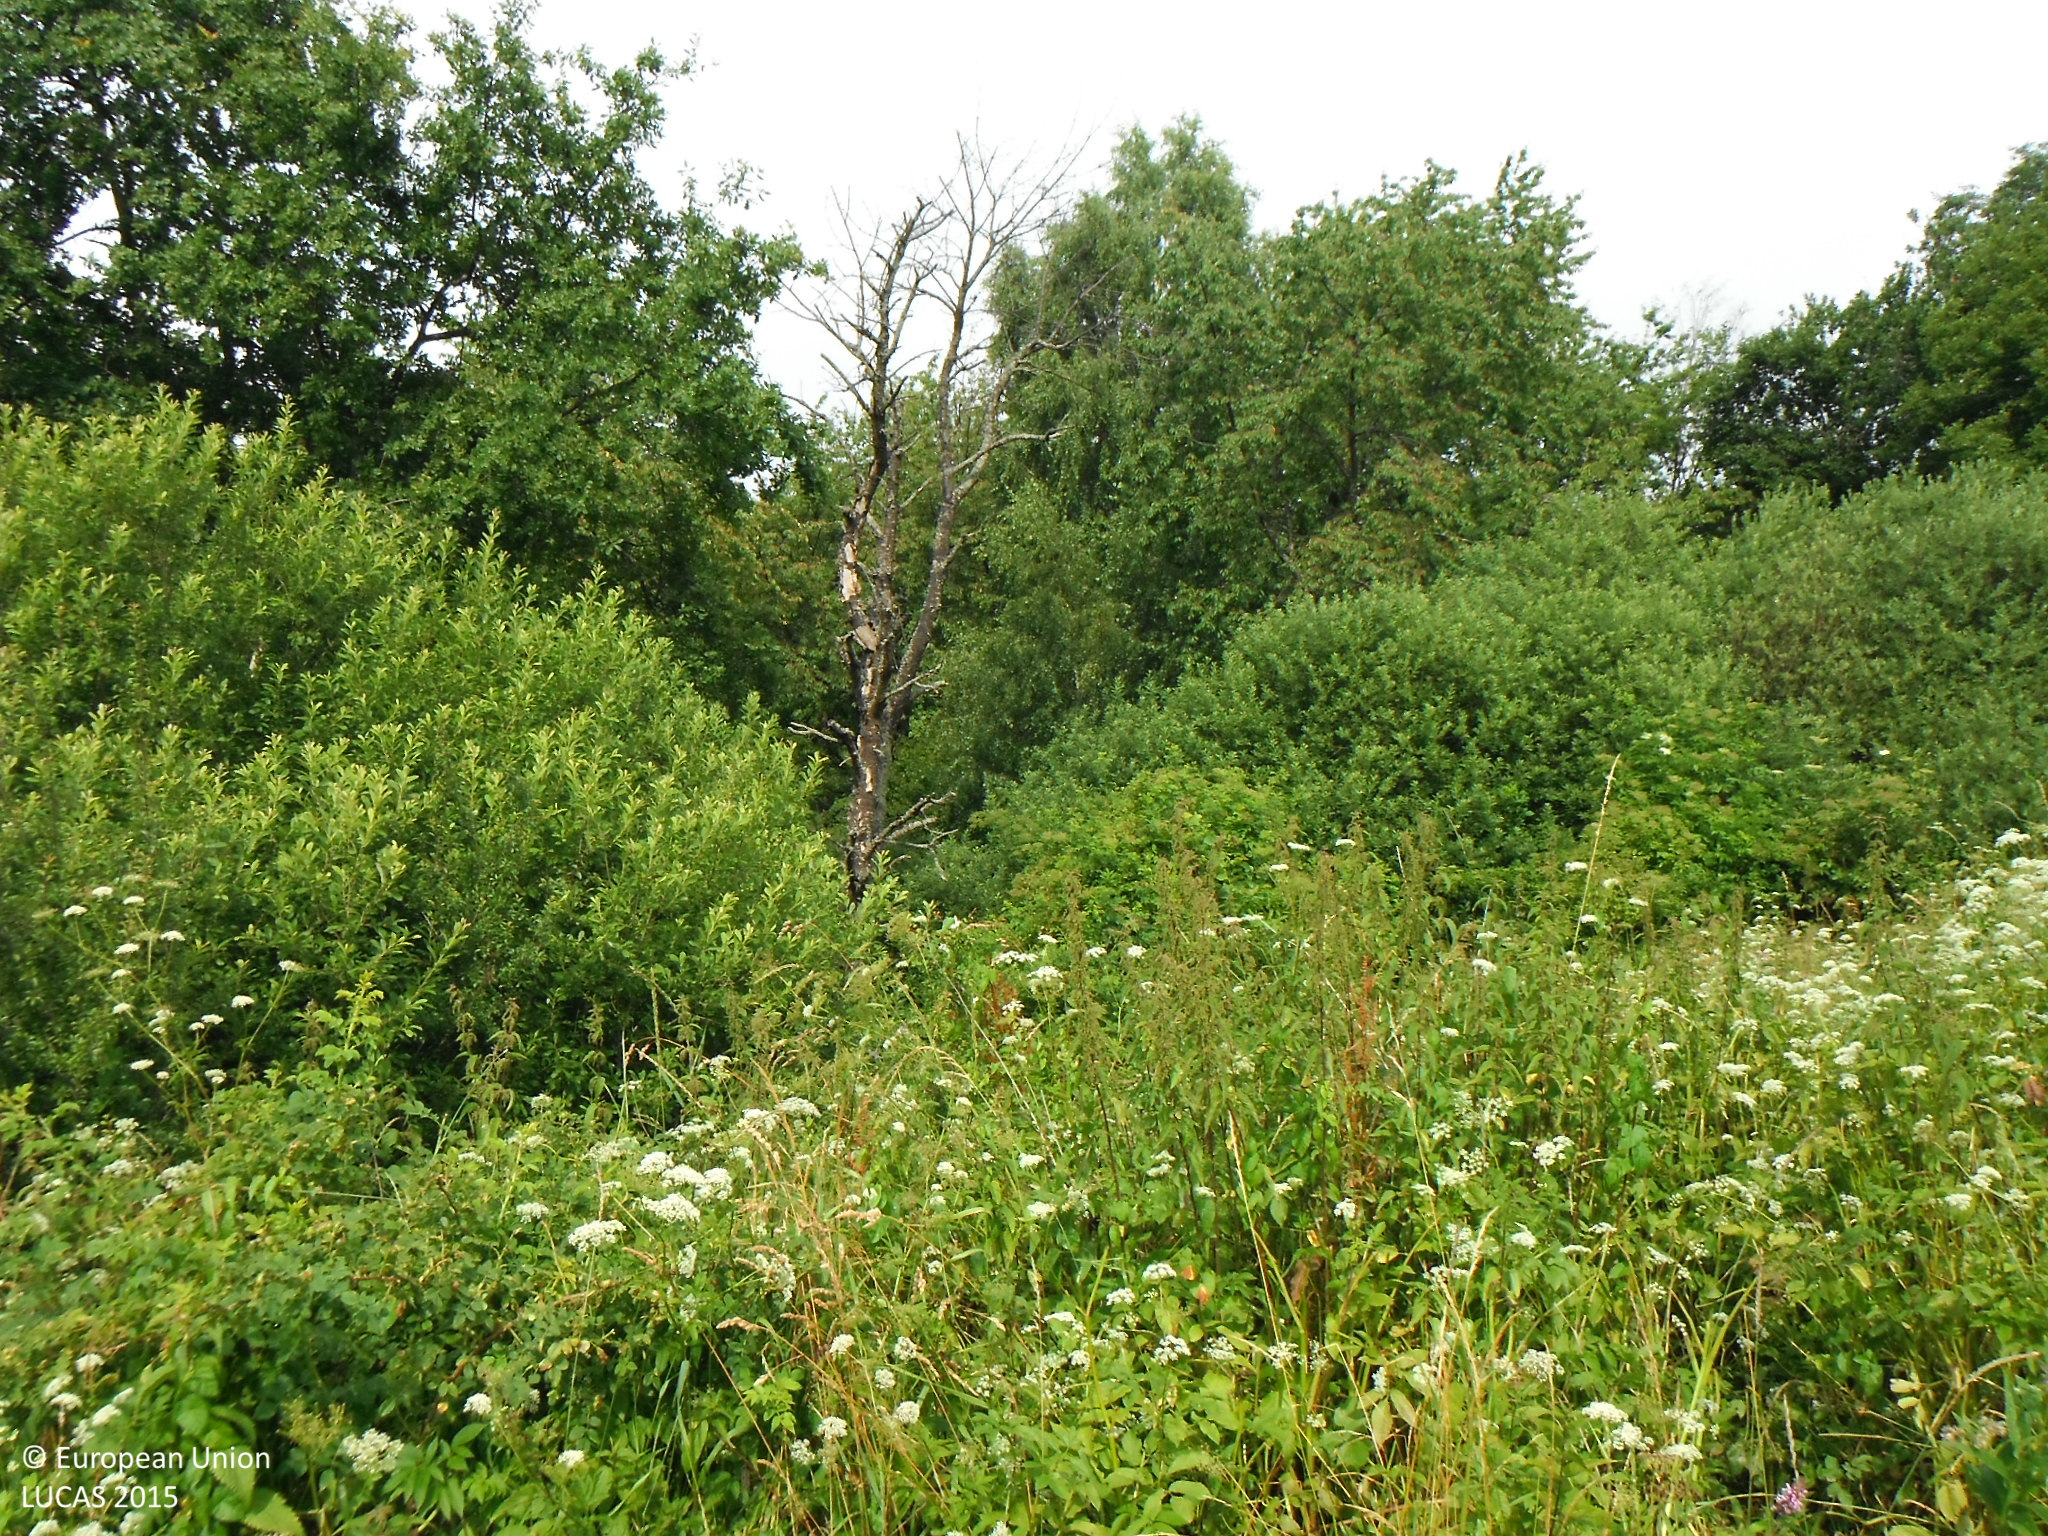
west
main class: Grassland
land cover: Spontaneously vegetated surfaces
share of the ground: > 75 %
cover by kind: herbaceous plants 95 %, shrubs 5 %
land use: Semi-natural and natural areas not in use
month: July
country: SK
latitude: 49.2749
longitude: 22.0004
